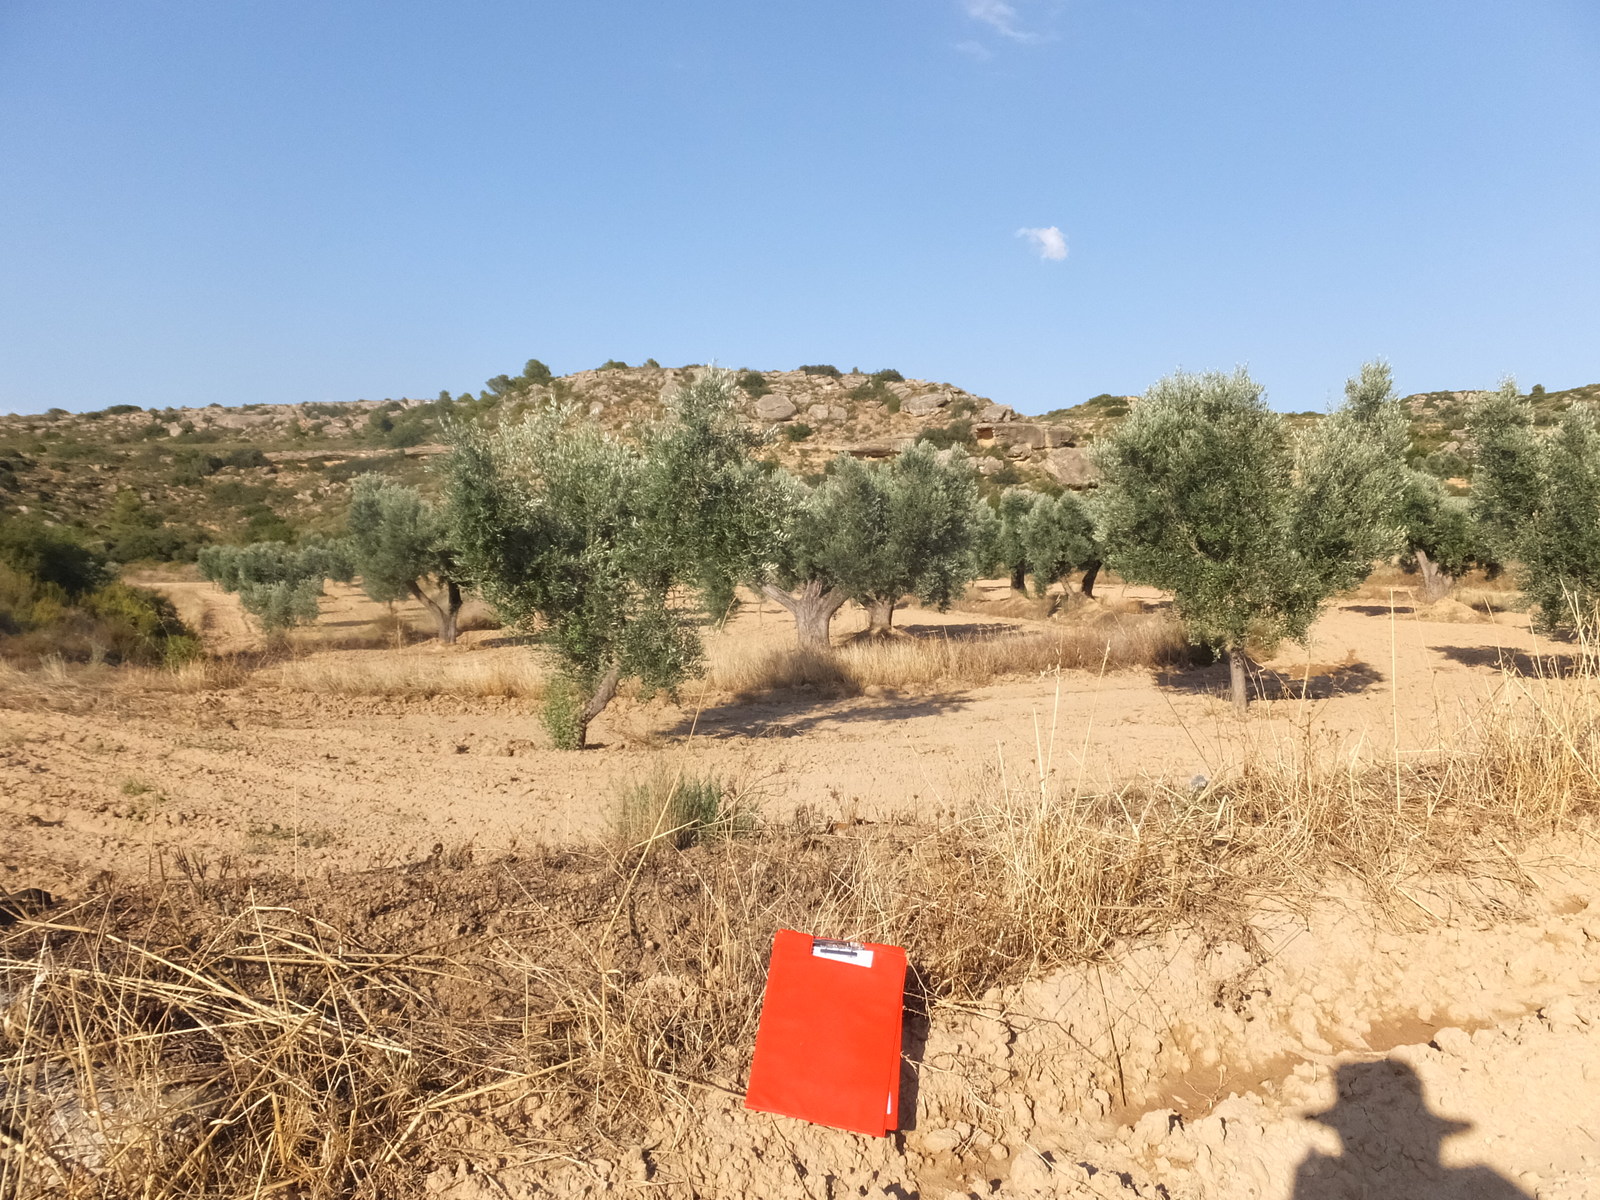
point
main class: Cropland
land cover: Olive groves
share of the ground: 50 - 75 %
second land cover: Other bare soil
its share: > 75 %
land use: Agriculture (excluding fallow land and kitchen gardens)
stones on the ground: < 10 %
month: July
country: ES
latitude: 41.0990
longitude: 0.1431
